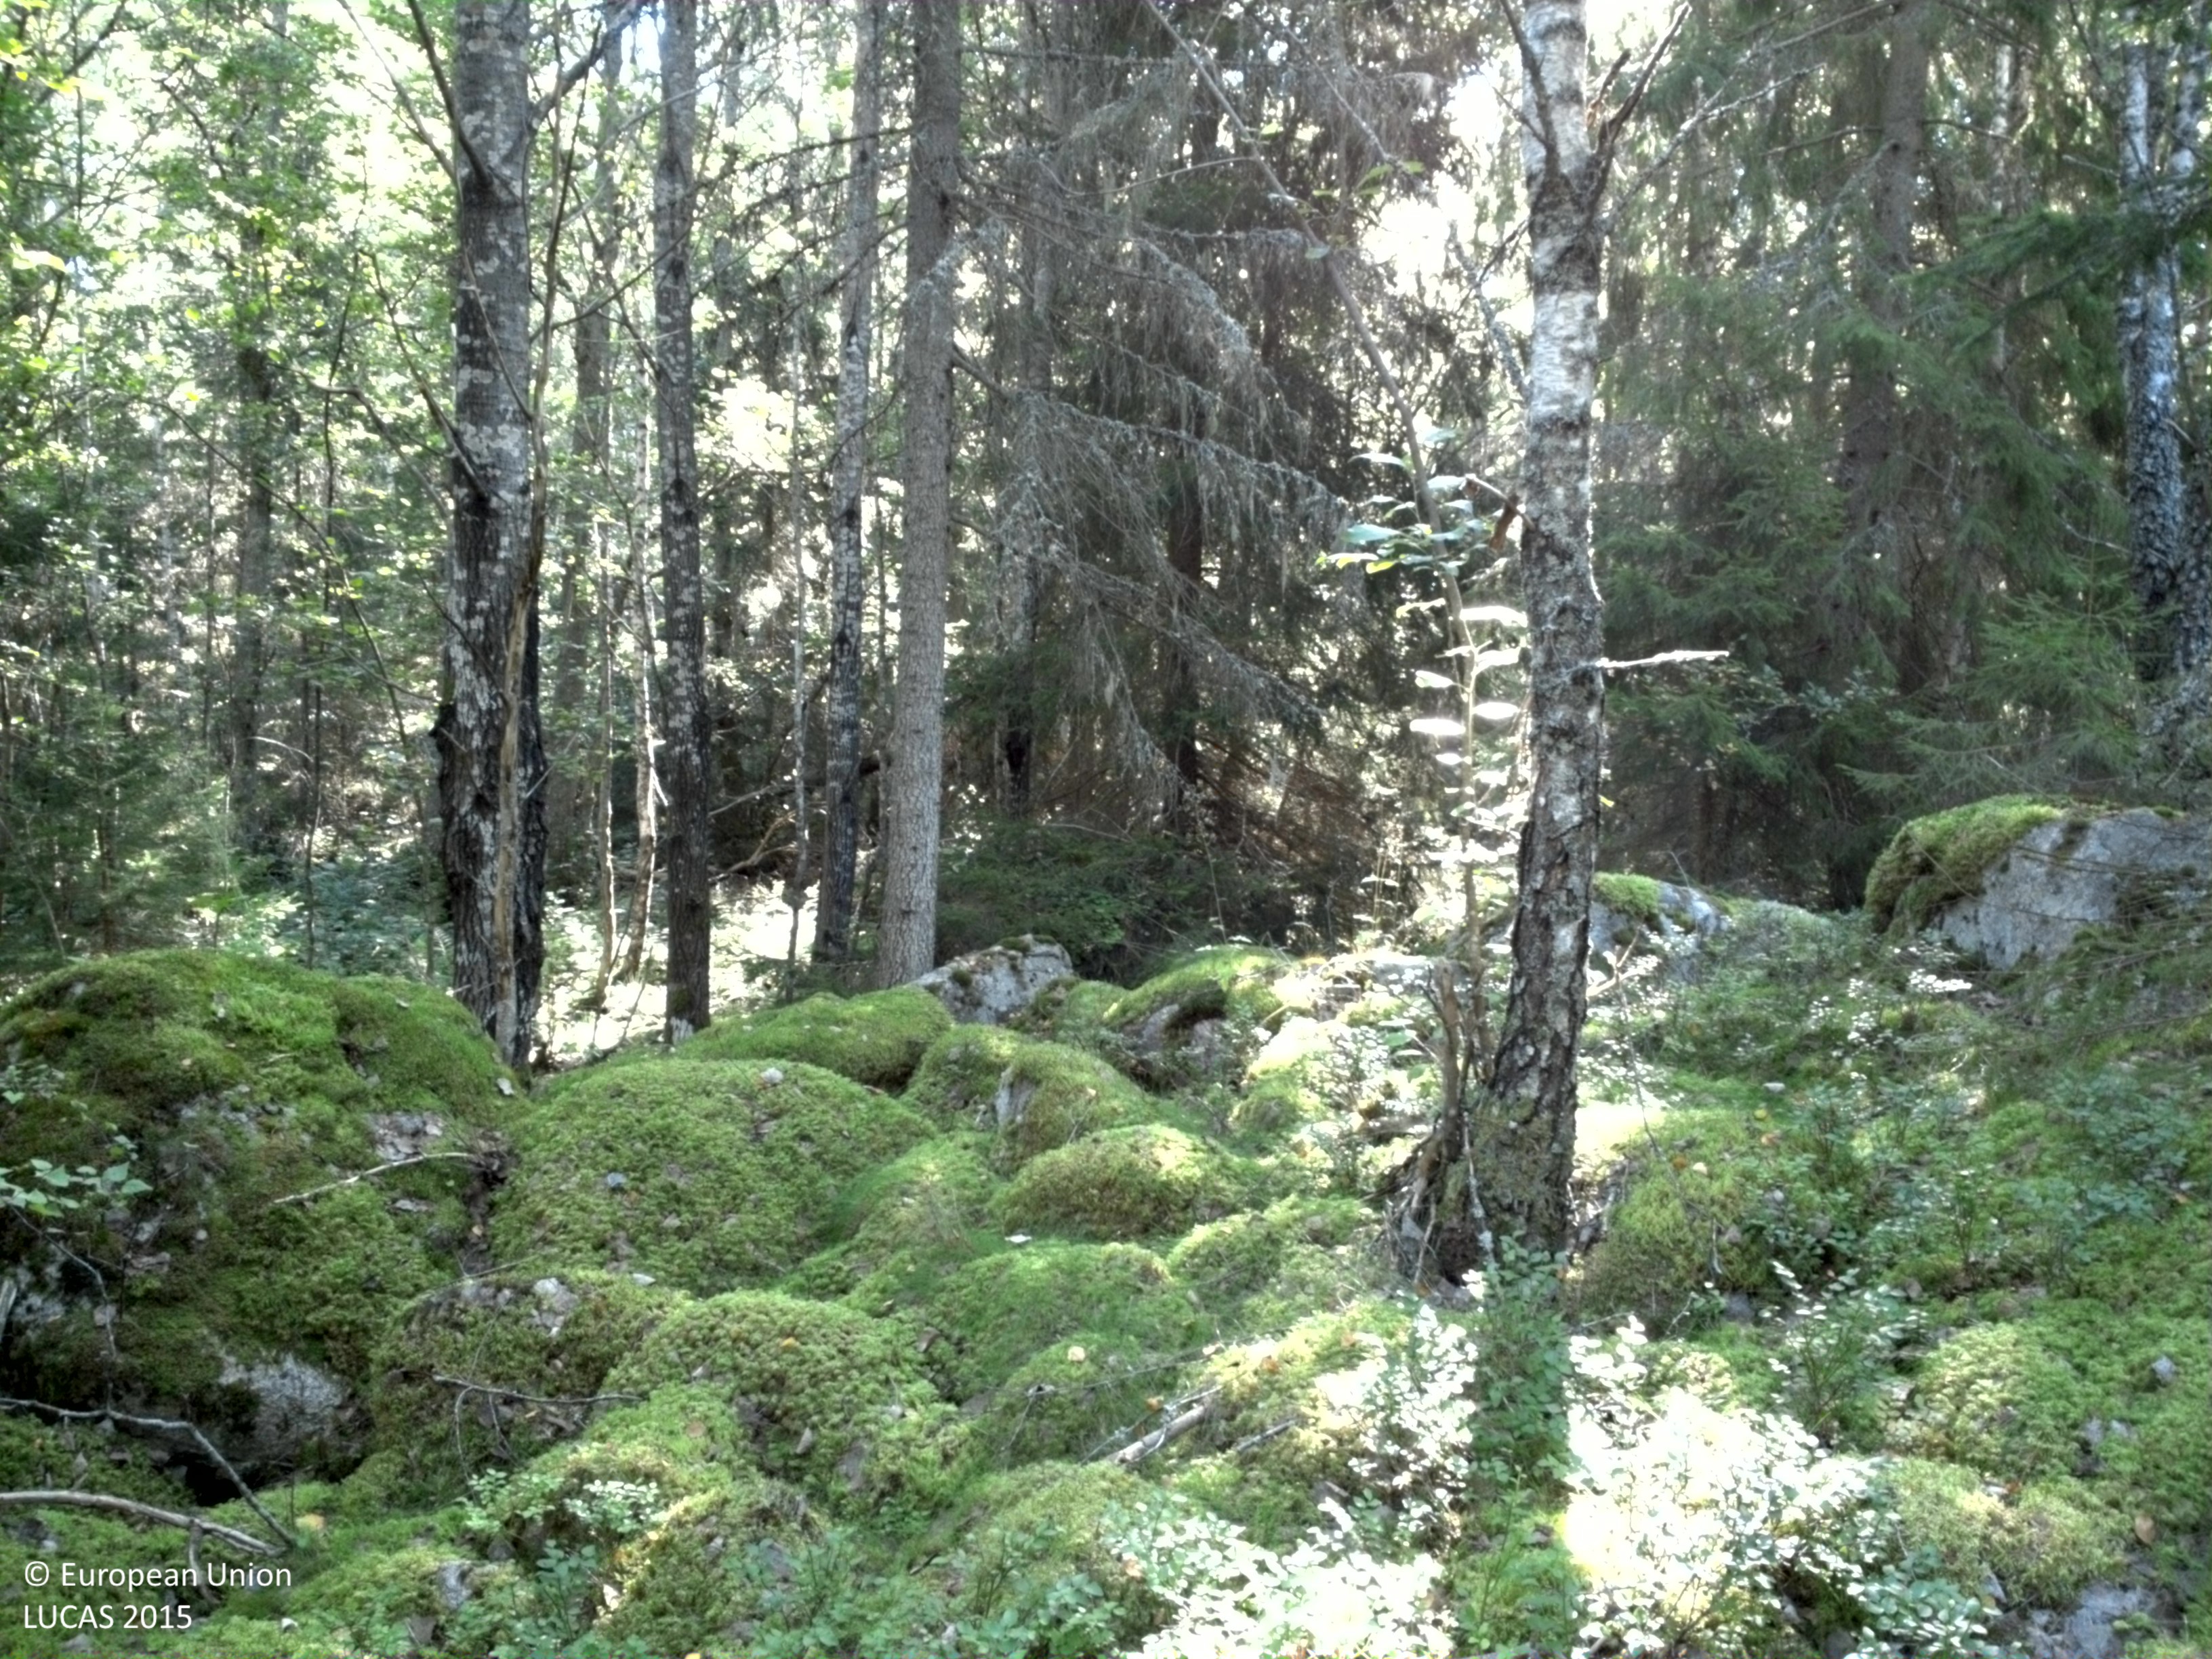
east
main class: Woodland
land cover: Spruce dominated mixed woodland
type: boreal forest
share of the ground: 50 - 75 %
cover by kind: coniferous forest trees 50 %, lichens and mosses 30 %, broadleaved forest trees 20 %
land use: Forestry
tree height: > 5 m
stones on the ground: 10 - 25 %
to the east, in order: Spruce dominated mixed woodland; Broadleaved woodland; Tracks; Spruce dominated coniferous woodland; Other coniferous woodland; Spruce dominated mixed woodland; Artificial constructions in urban areas
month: August
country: SE
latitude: 59.7812
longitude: 17.1716
